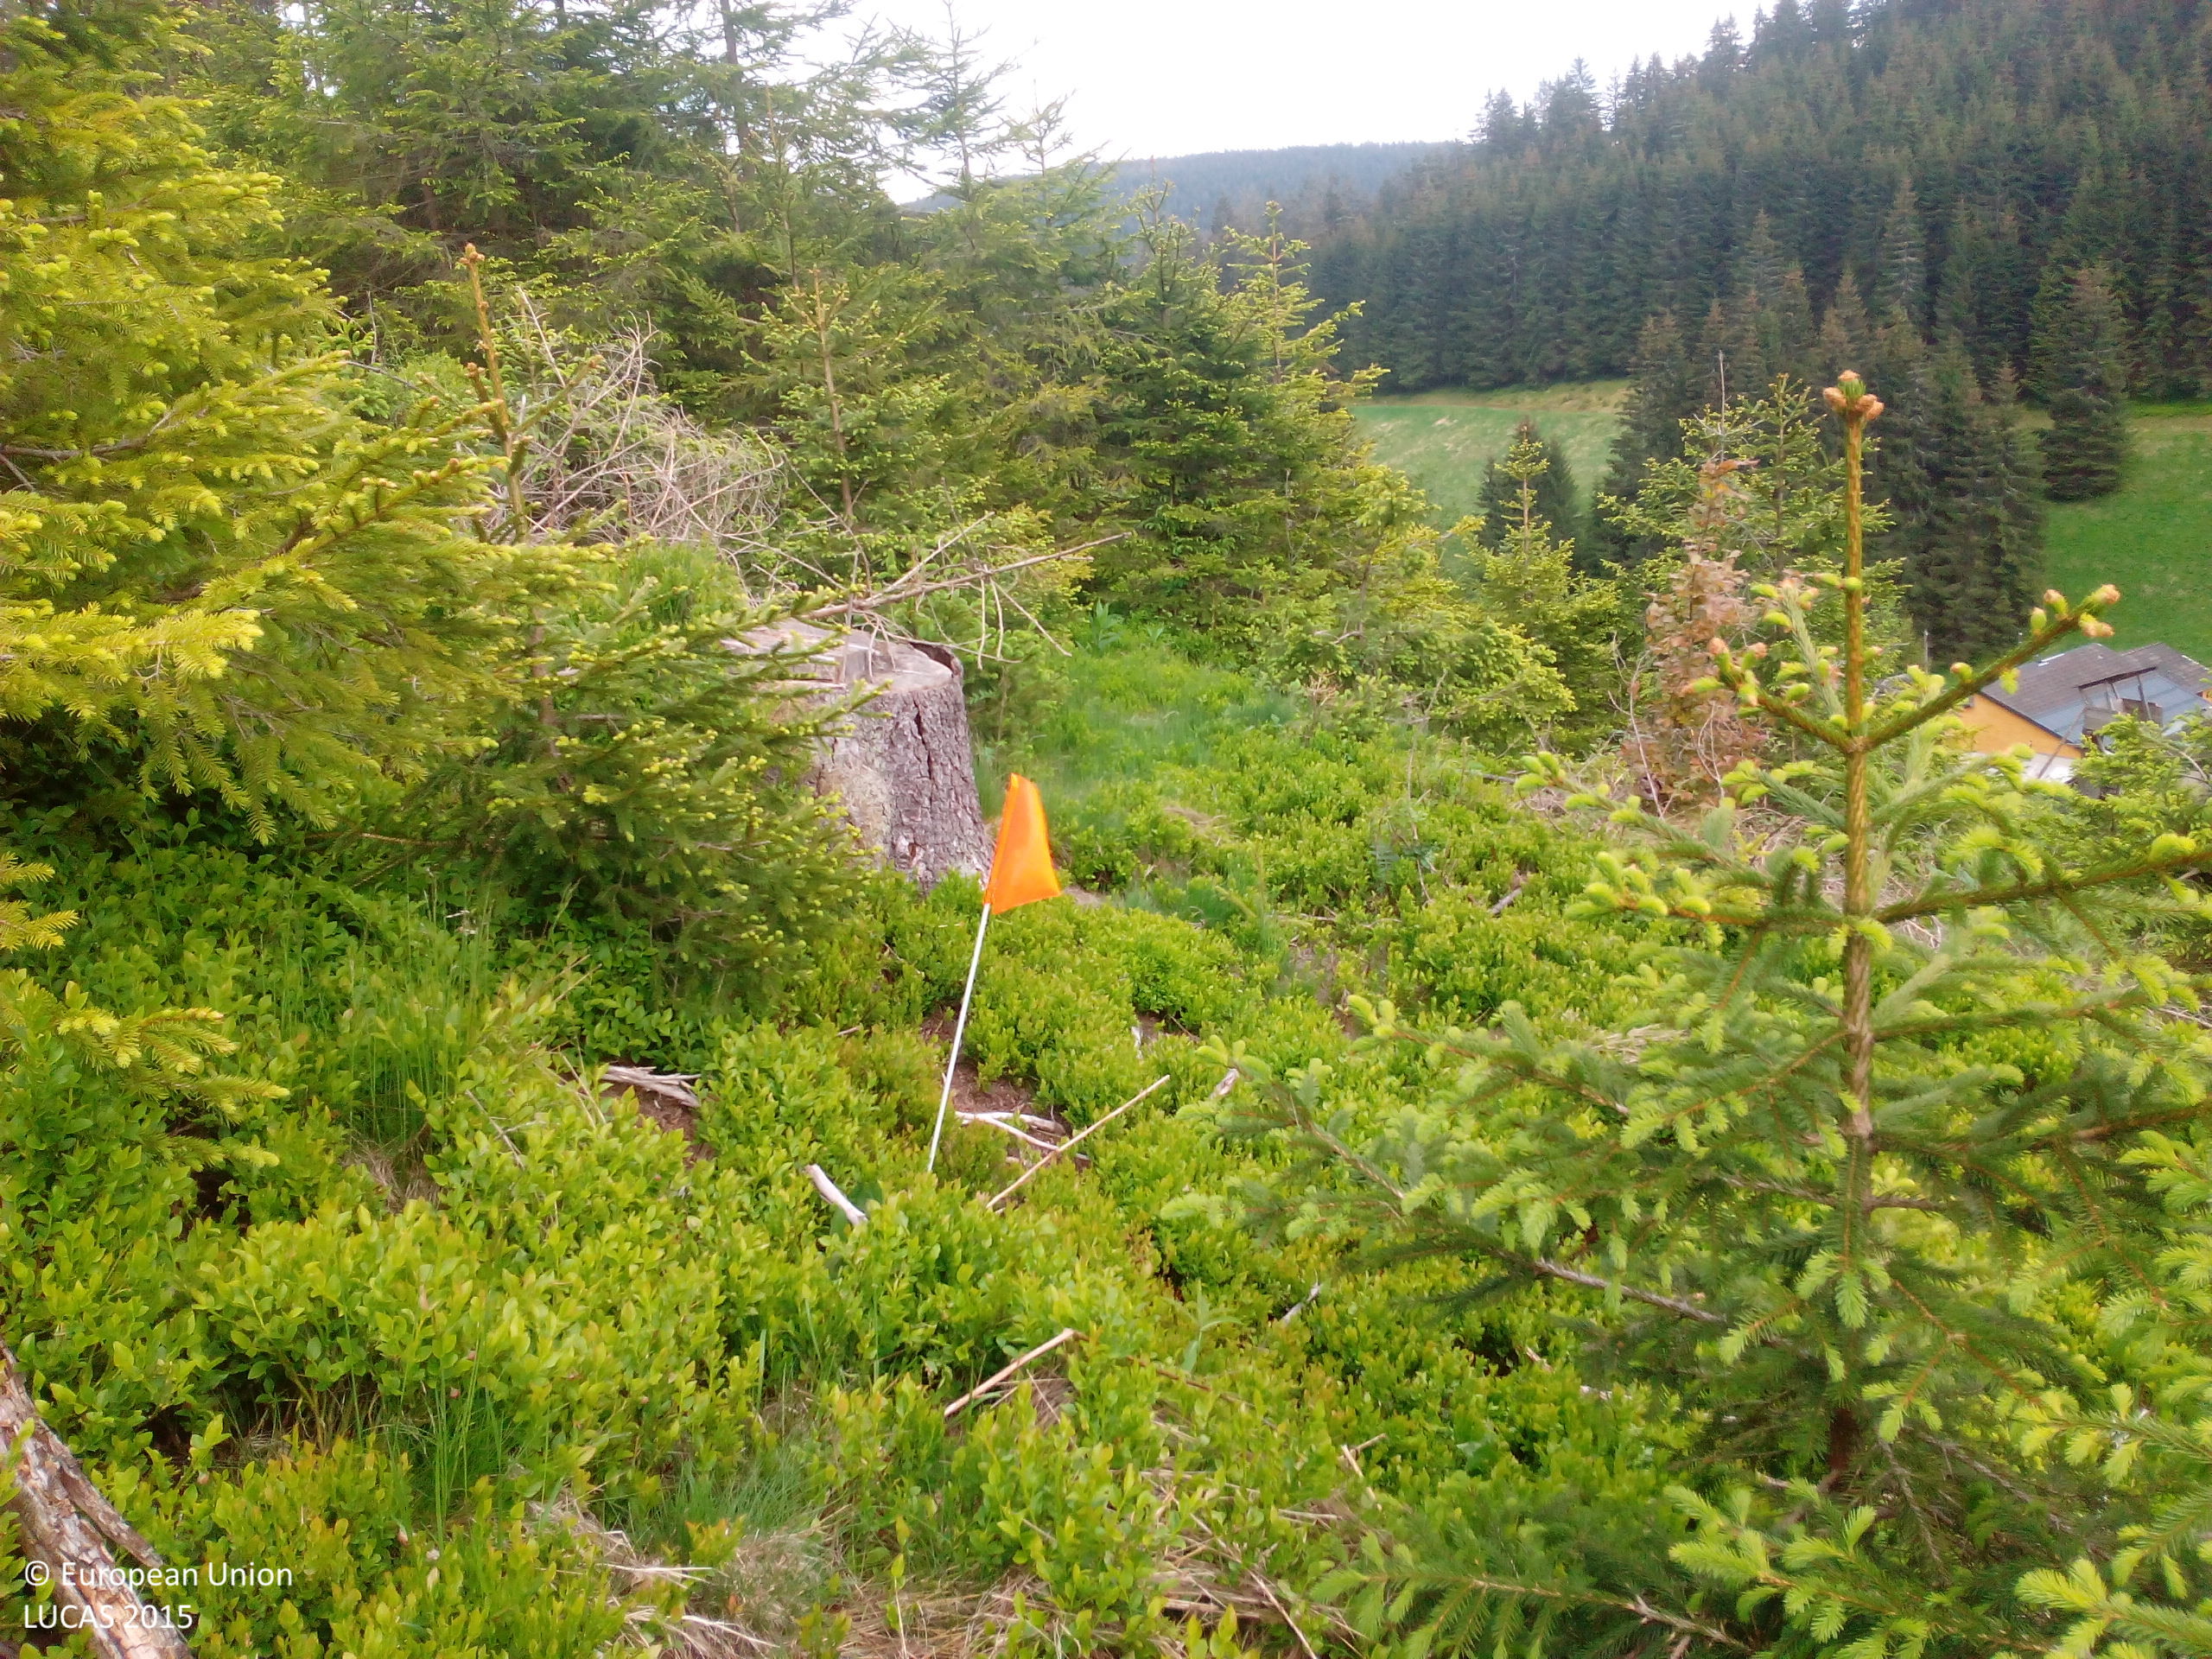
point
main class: Woodland
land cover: Spruce dominated coniferous woodland
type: hemiboreal forest and nemoral coniferous forest and mixed broadleaved-coniferous forest
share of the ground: 25 - 50 %
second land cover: Shrubland without tree cover
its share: 50 - 75 %
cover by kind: coniferous forest trees 40 %, shrubs 40 %, herbaceous plants 20 %
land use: Forestry
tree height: < 5 m
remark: Clear cut
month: May
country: DE
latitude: 48.0647
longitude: 8.1894
